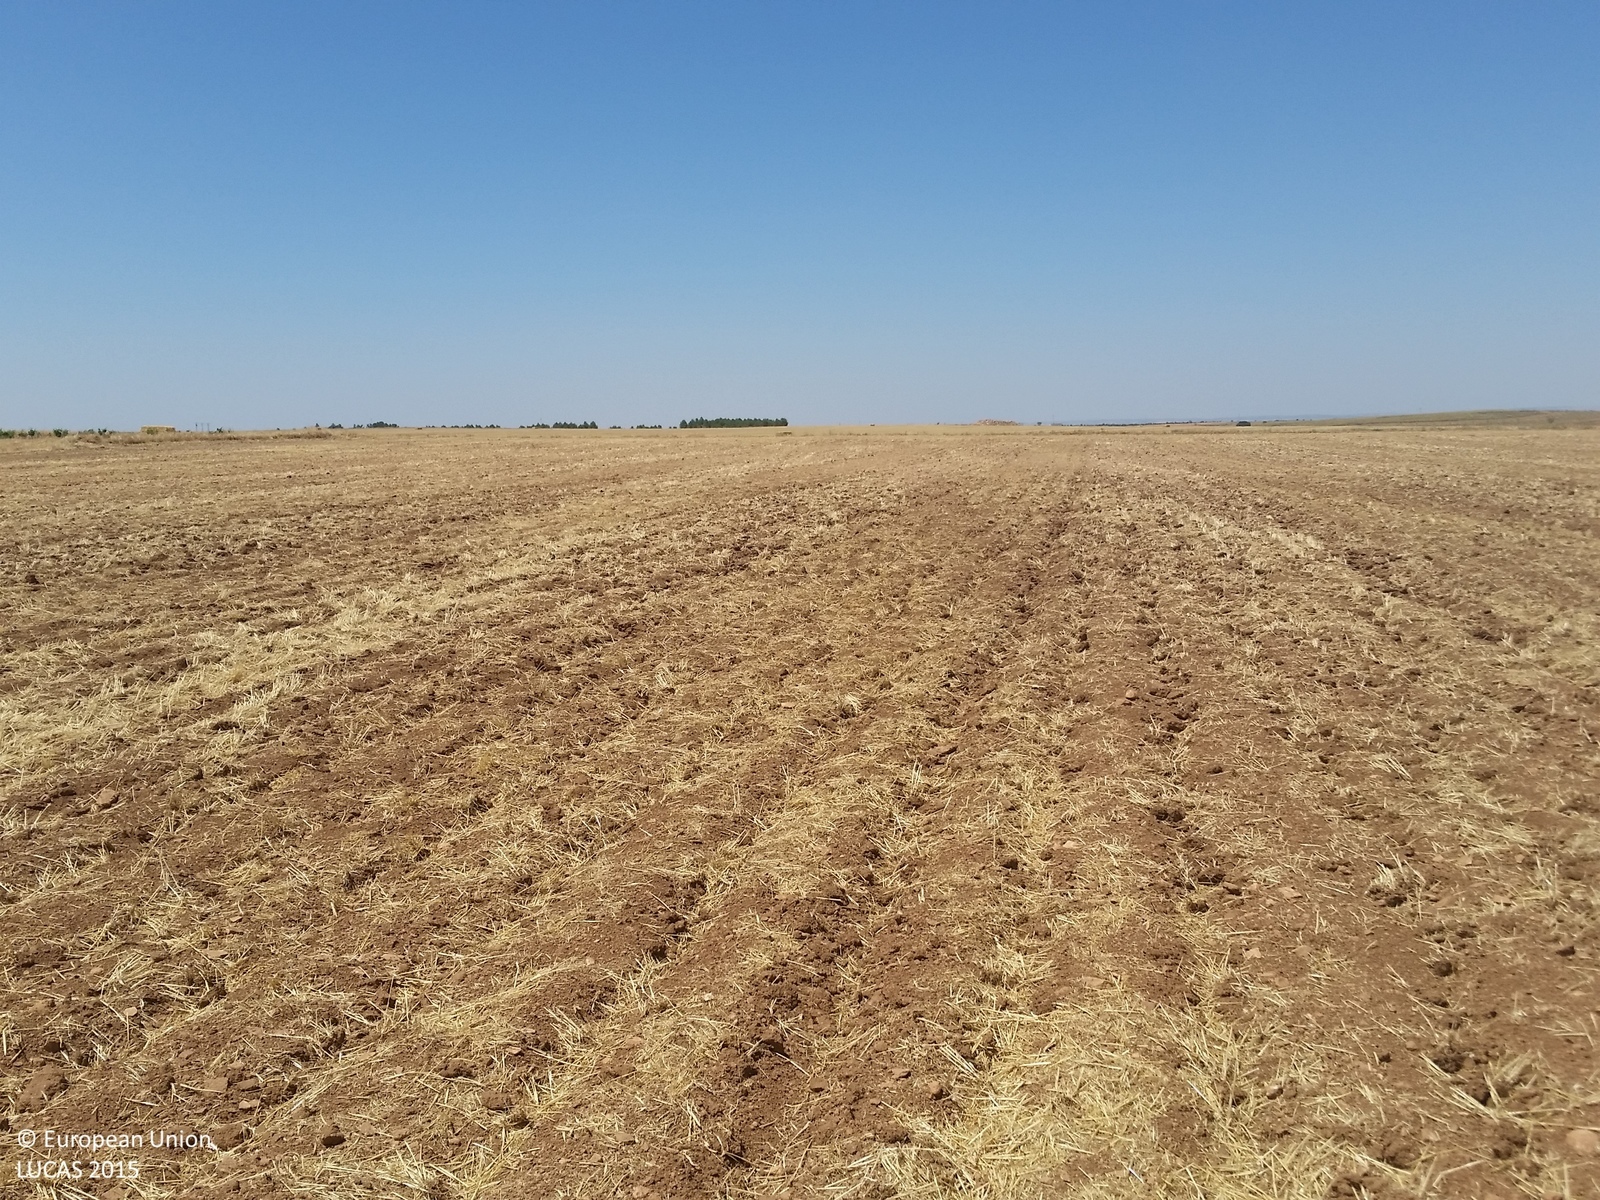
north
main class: Cropland
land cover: Barley
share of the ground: < 10 %
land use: Agriculture (excluding fallow land and kitchen gardens)
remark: Harvested field
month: July
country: ES
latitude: 39.1633
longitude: -2.5654
